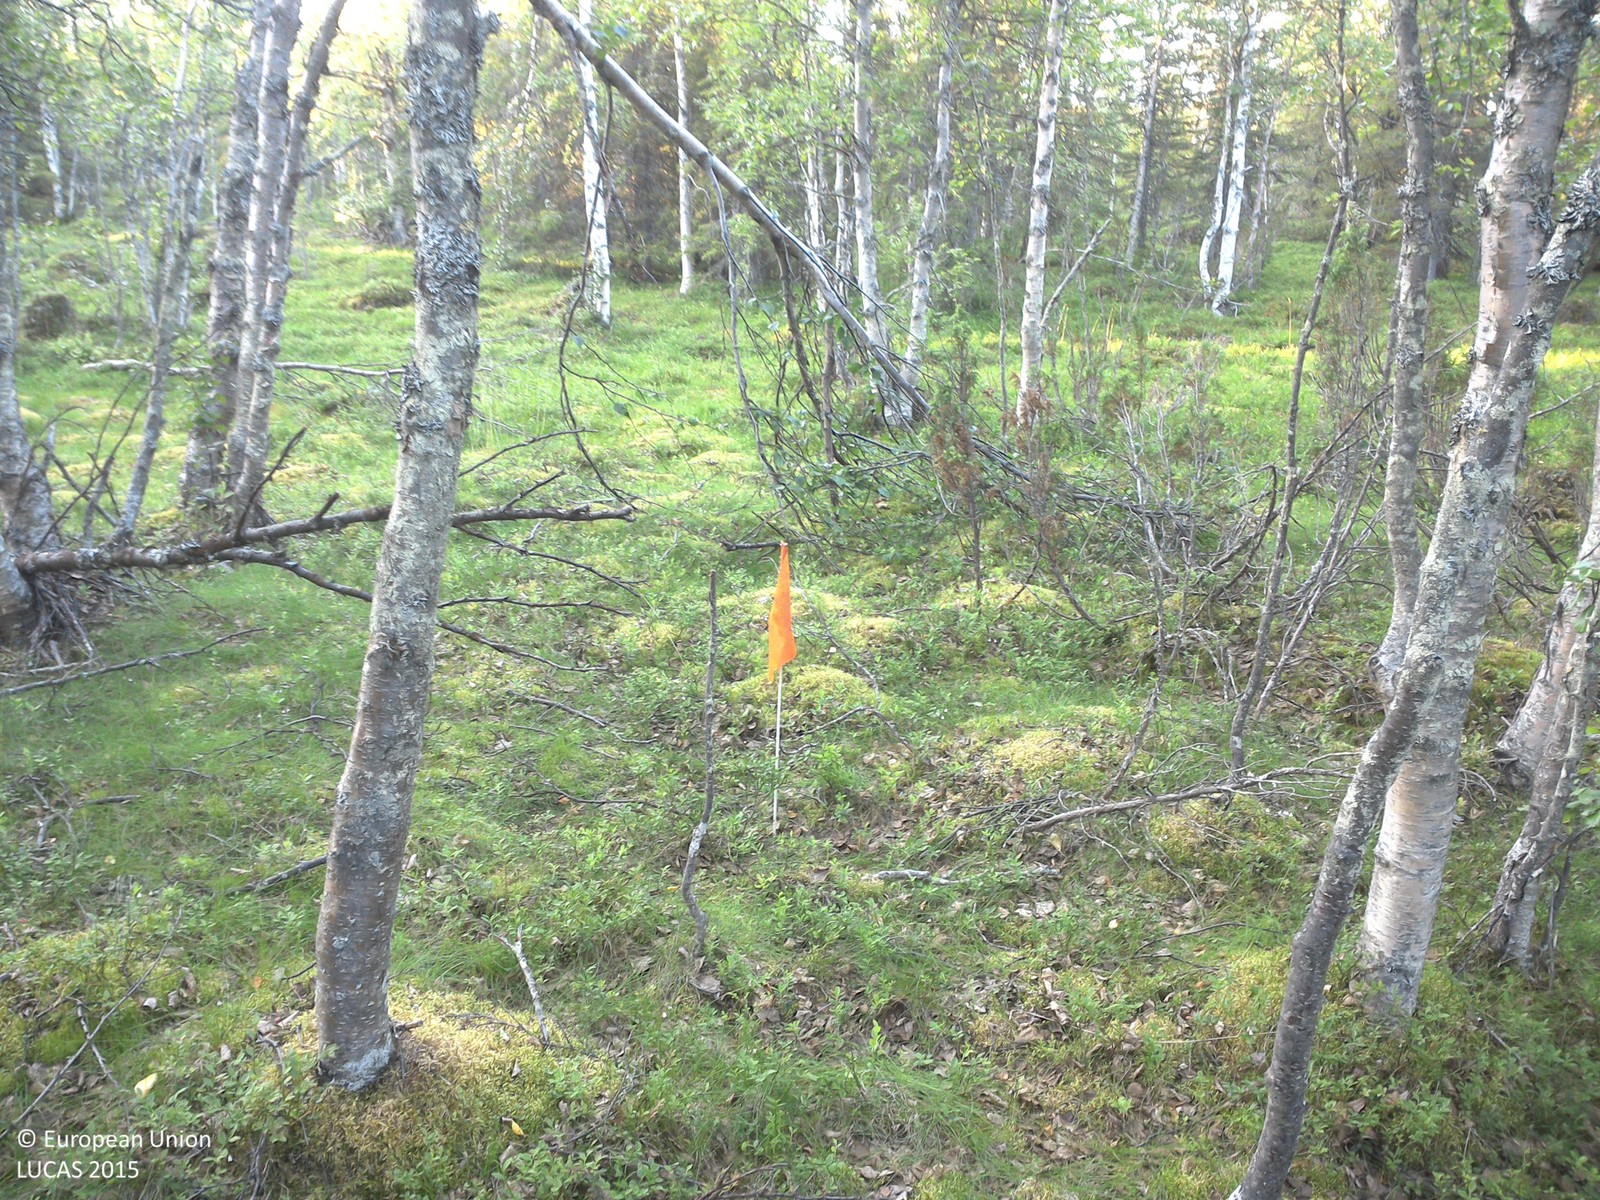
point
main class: Woodland
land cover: Spruce dominated mixed woodland
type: boreal forest
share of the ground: 25 - 50 %
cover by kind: shrubs 40 %, coniferous forest trees 20 %, lichens and mosses 20 %, broadleaved forest trees 15 %, herbaceous plants 5 %
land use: Forestry
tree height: > 5 m
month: August
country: SE
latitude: 67.3009
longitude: 21.1196
